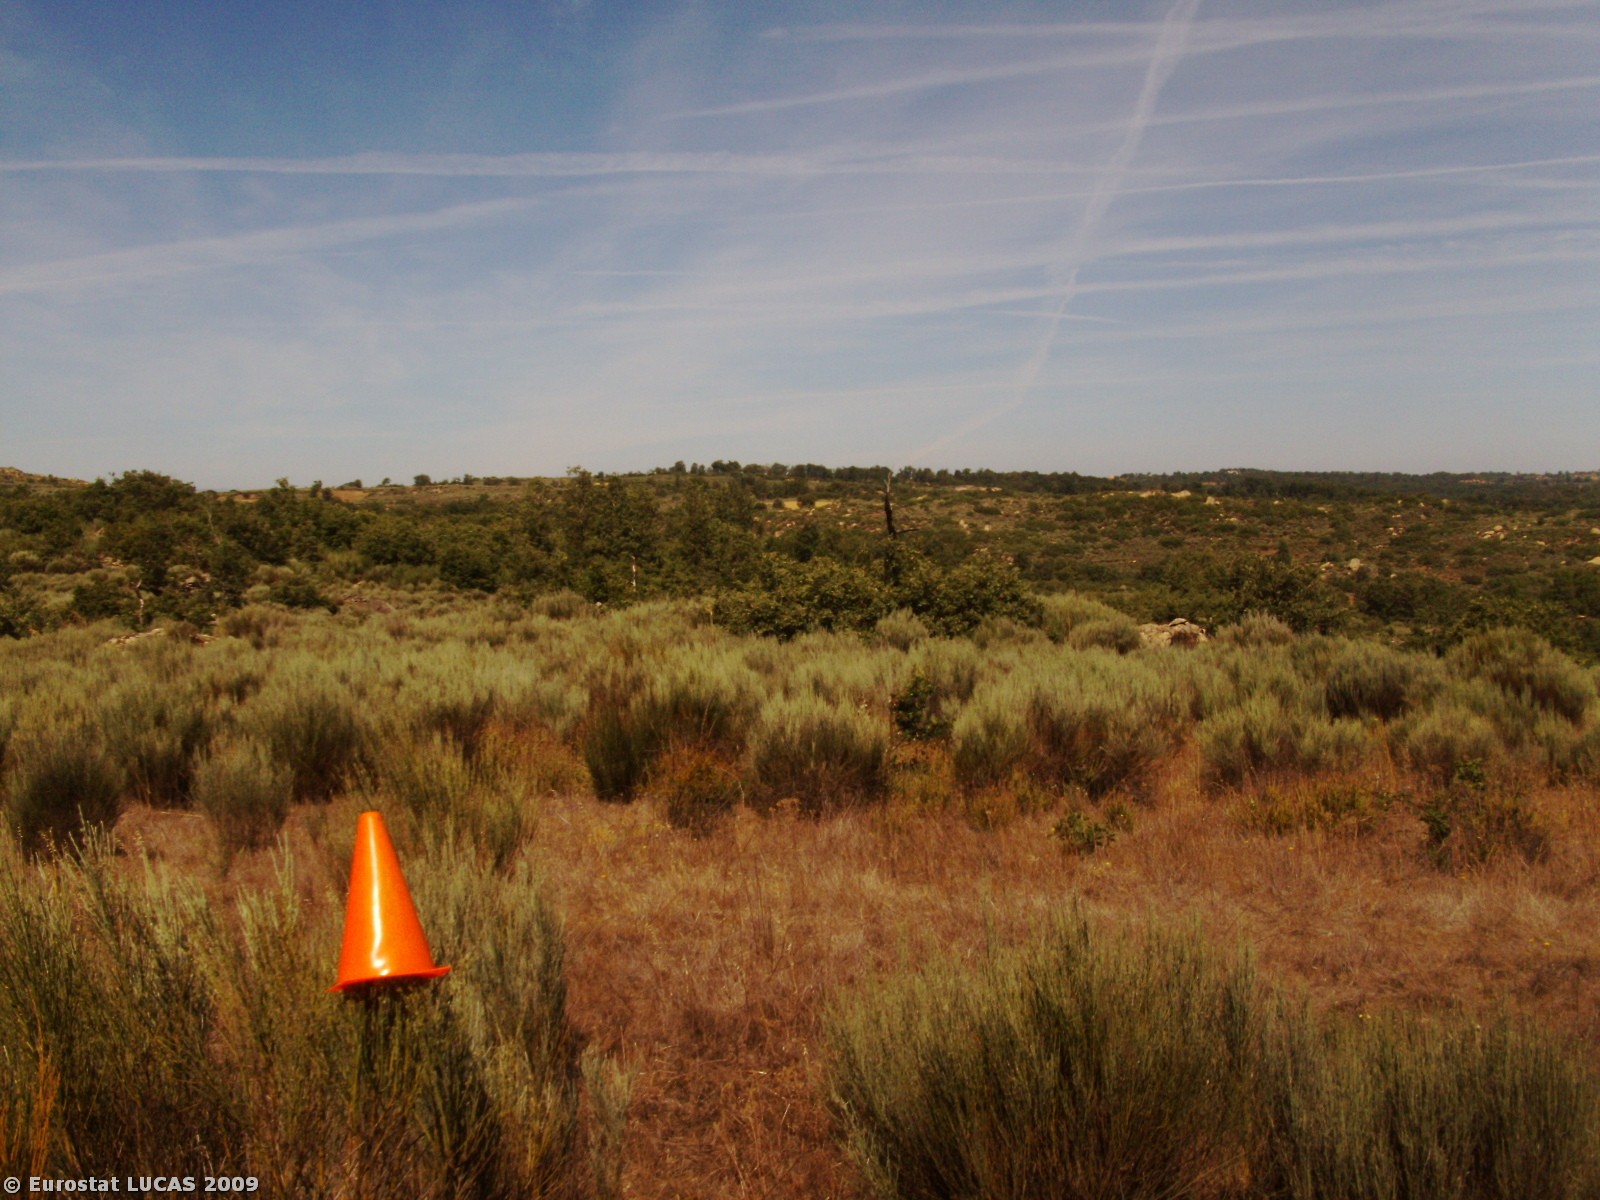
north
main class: Shrubland
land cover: Shrubland without tree cover
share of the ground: > 75 %
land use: Fallow land
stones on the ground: > 50 %
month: July
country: PT
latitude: 40.4556
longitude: -7.0684
